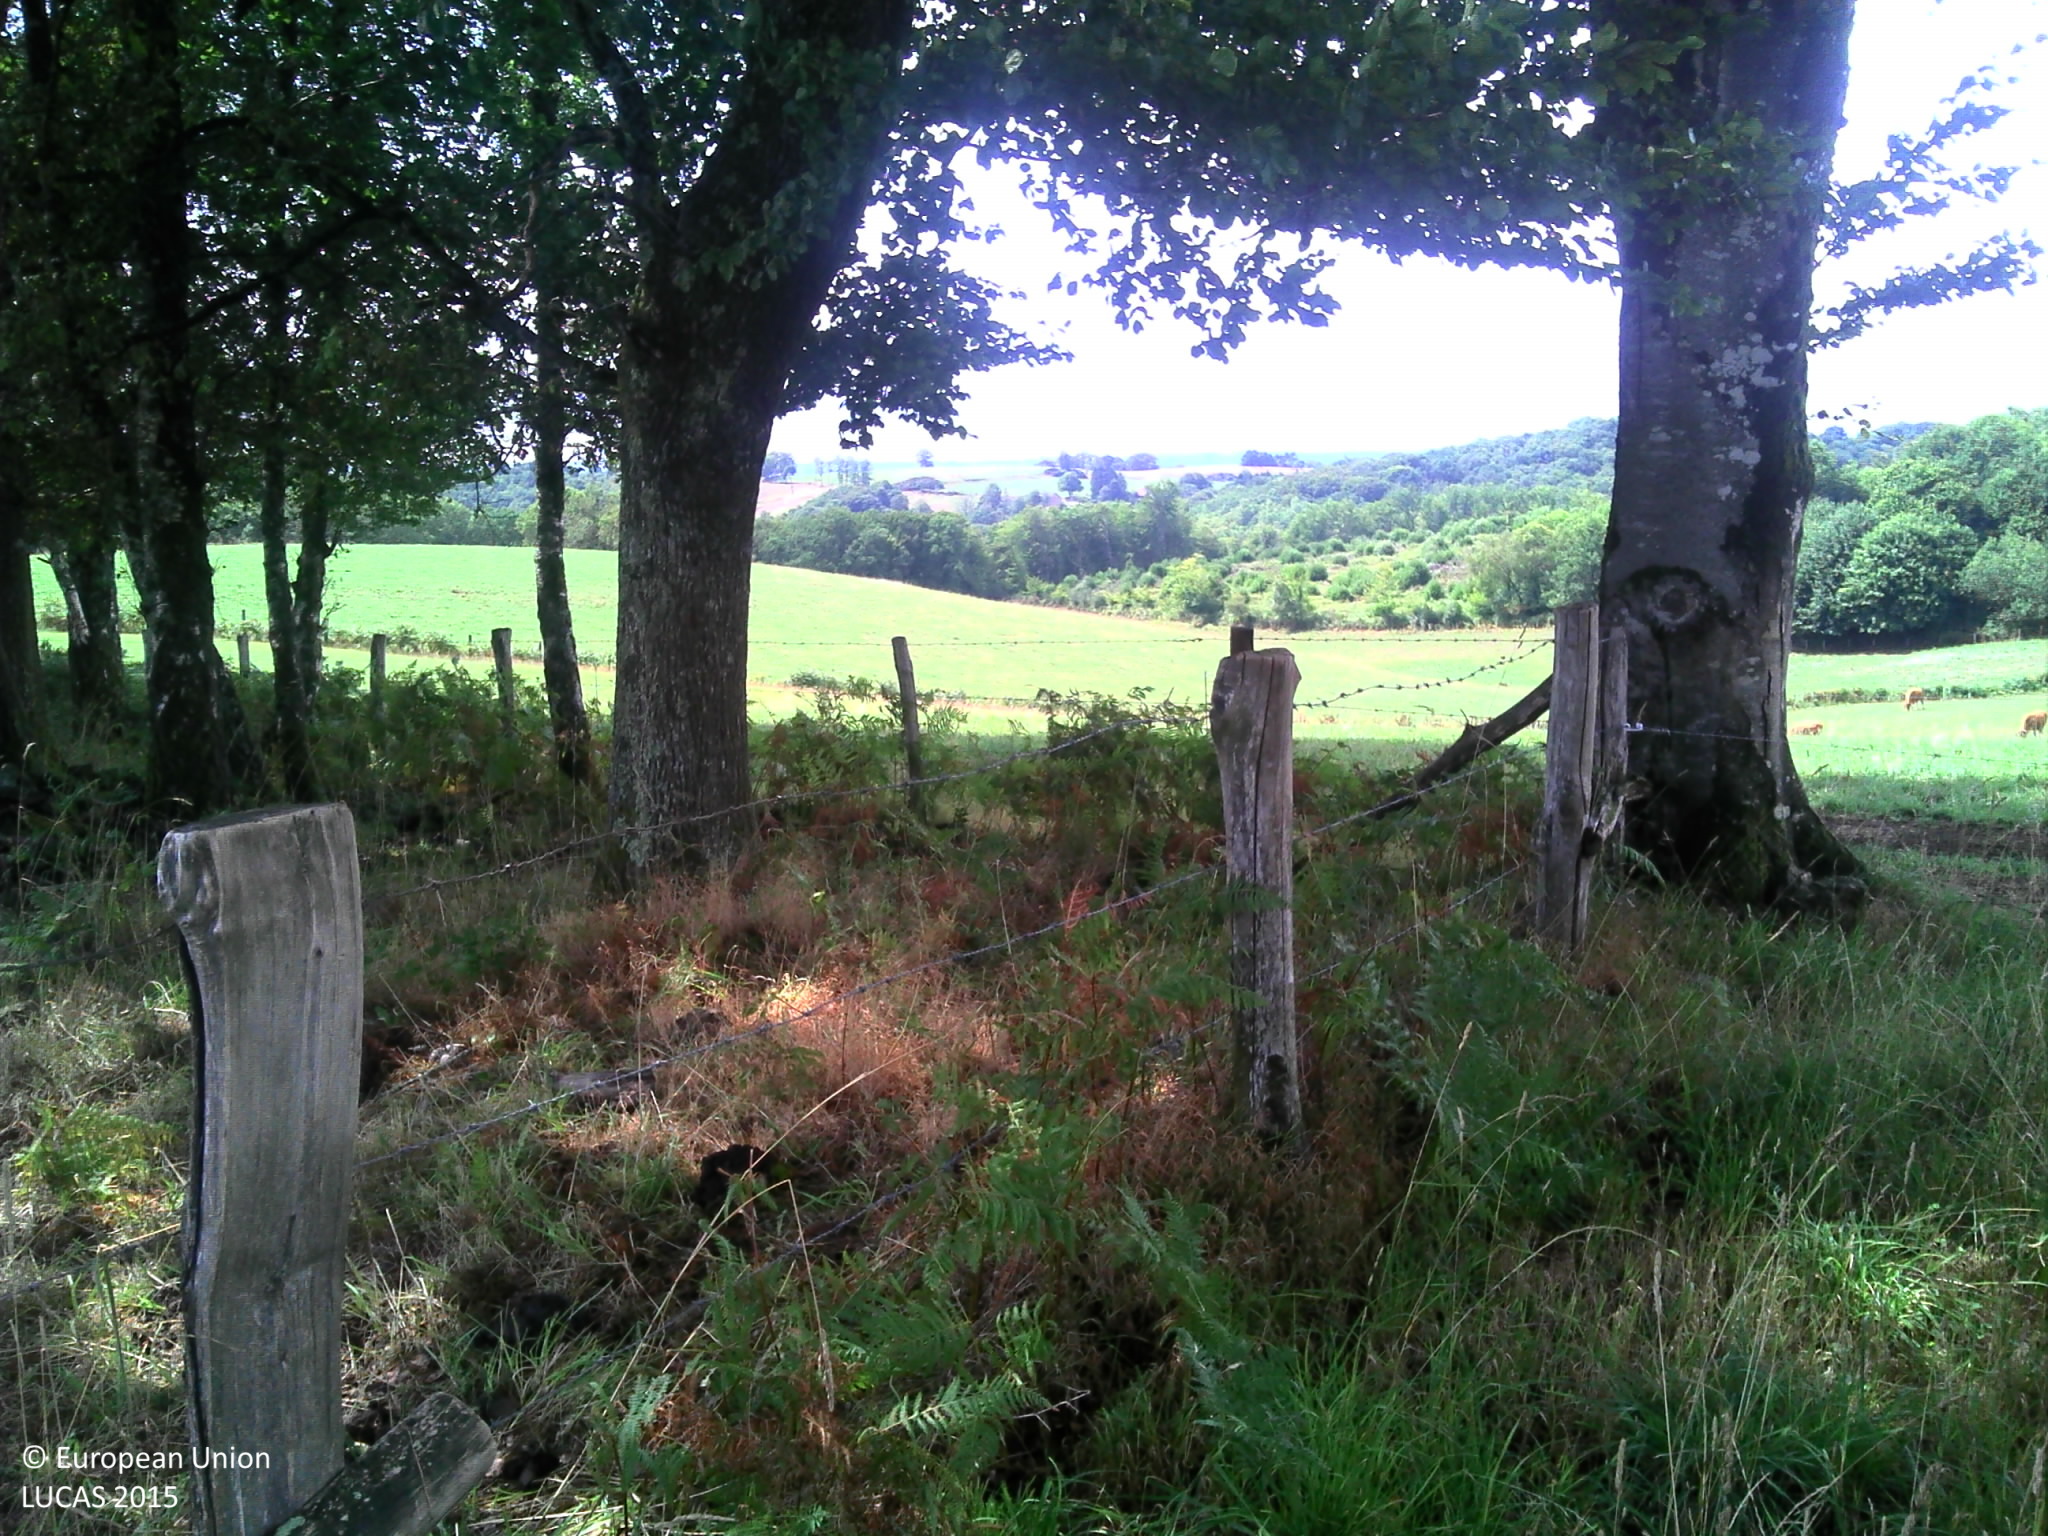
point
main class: Grassland
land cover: Grassland without tree/shrub cover
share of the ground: > 75 %
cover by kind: herbaceous plants 100 %
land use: Agriculture (excluding fallow land and kitchen gardens)
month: August
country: FR
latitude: 45.4546
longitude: 1.7730
